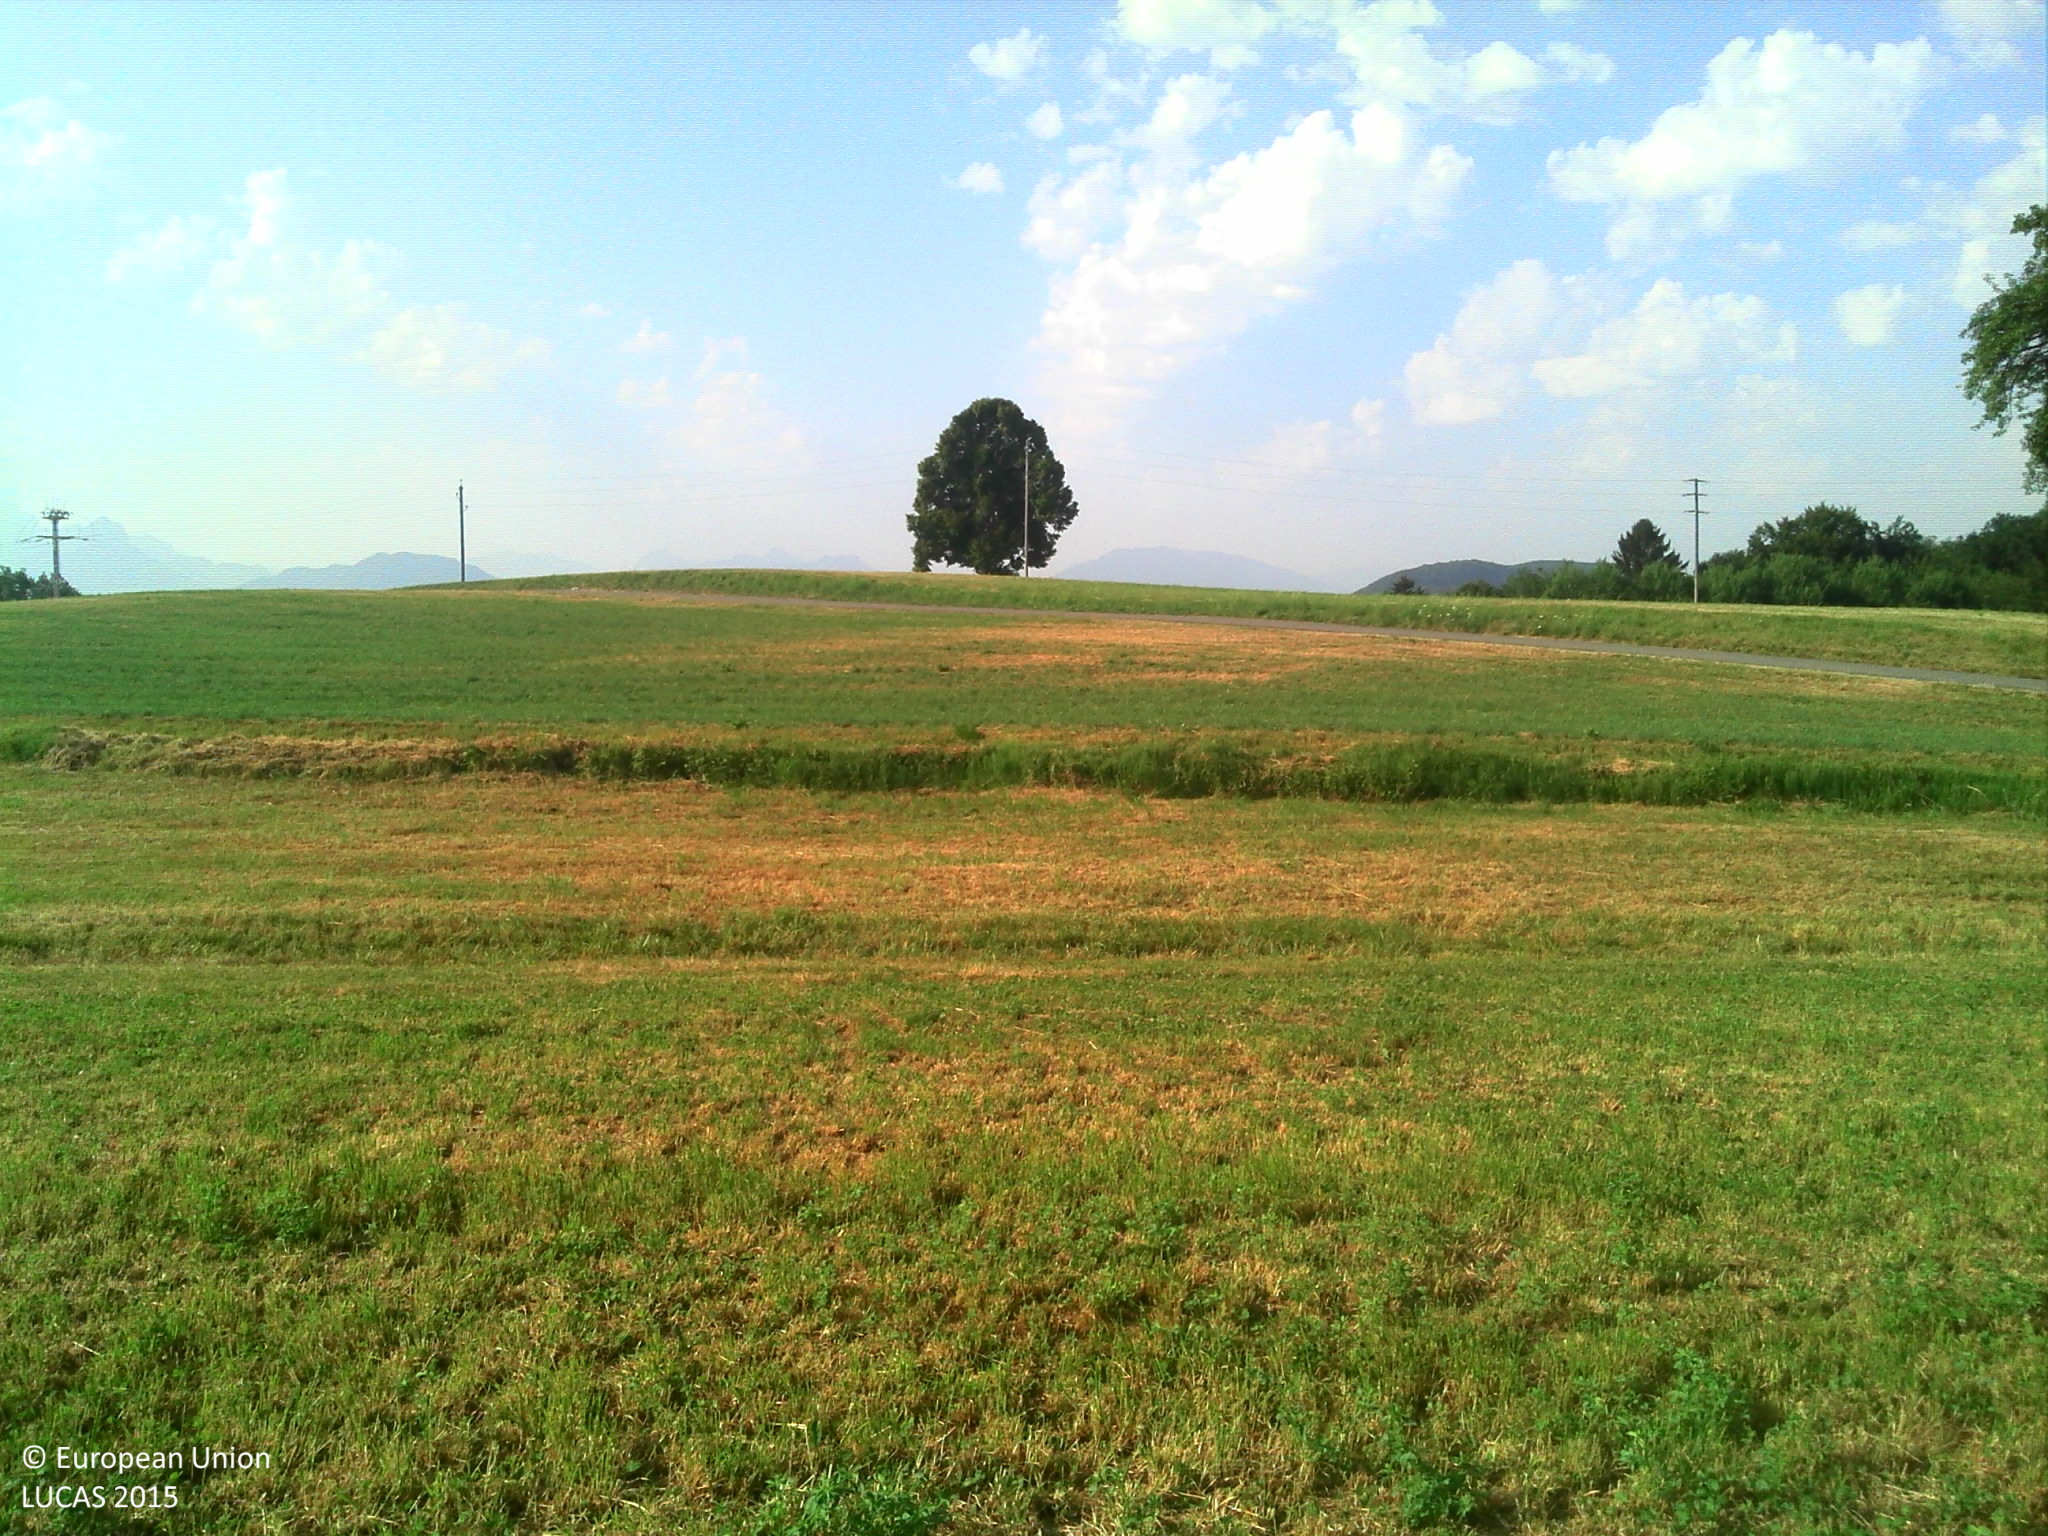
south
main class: Grassland
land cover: Grassland without tree/shrub cover
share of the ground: > 75 %
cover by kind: herbaceous plants 100 %
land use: Agriculture (excluding fallow land and kitchen gardens)
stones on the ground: < 10 %
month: July
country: FR
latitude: 46.0282
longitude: 6.1151
